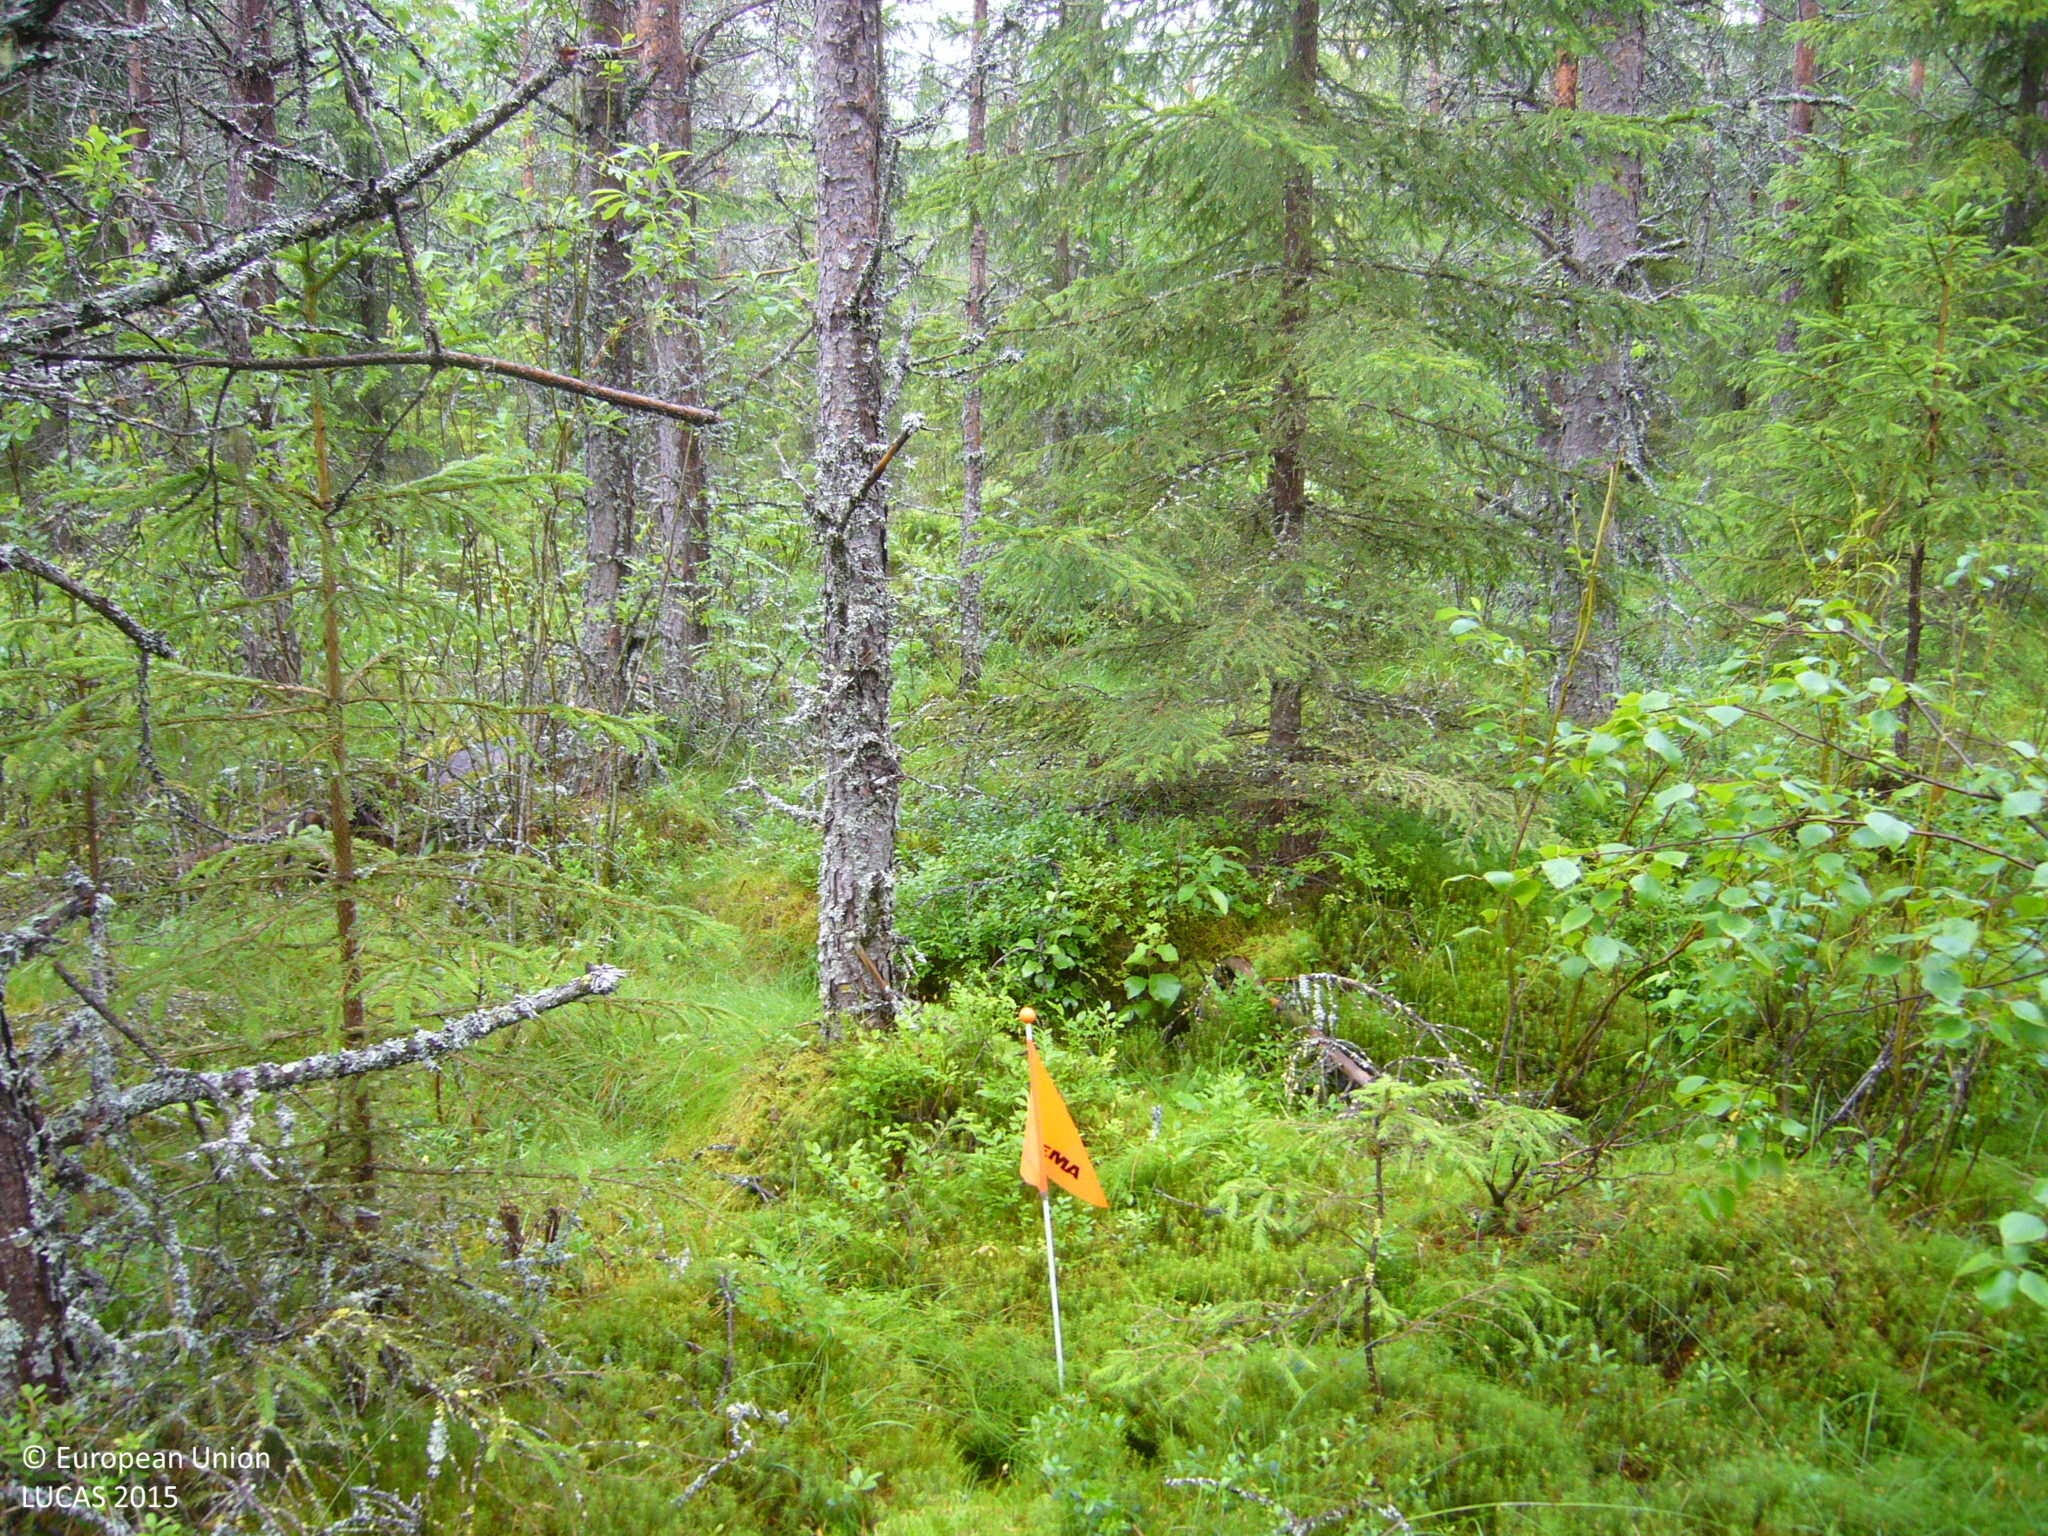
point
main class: Woodland
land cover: Pine dominated mixed woodland
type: boreal forest
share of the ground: > 75 %
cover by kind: coniferous forest trees 50 %, broadleaved forest trees 25 %, shrubs 25 %
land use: Forestry
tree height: > 5 m
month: July
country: FI
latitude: 63.8523
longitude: 26.0355
